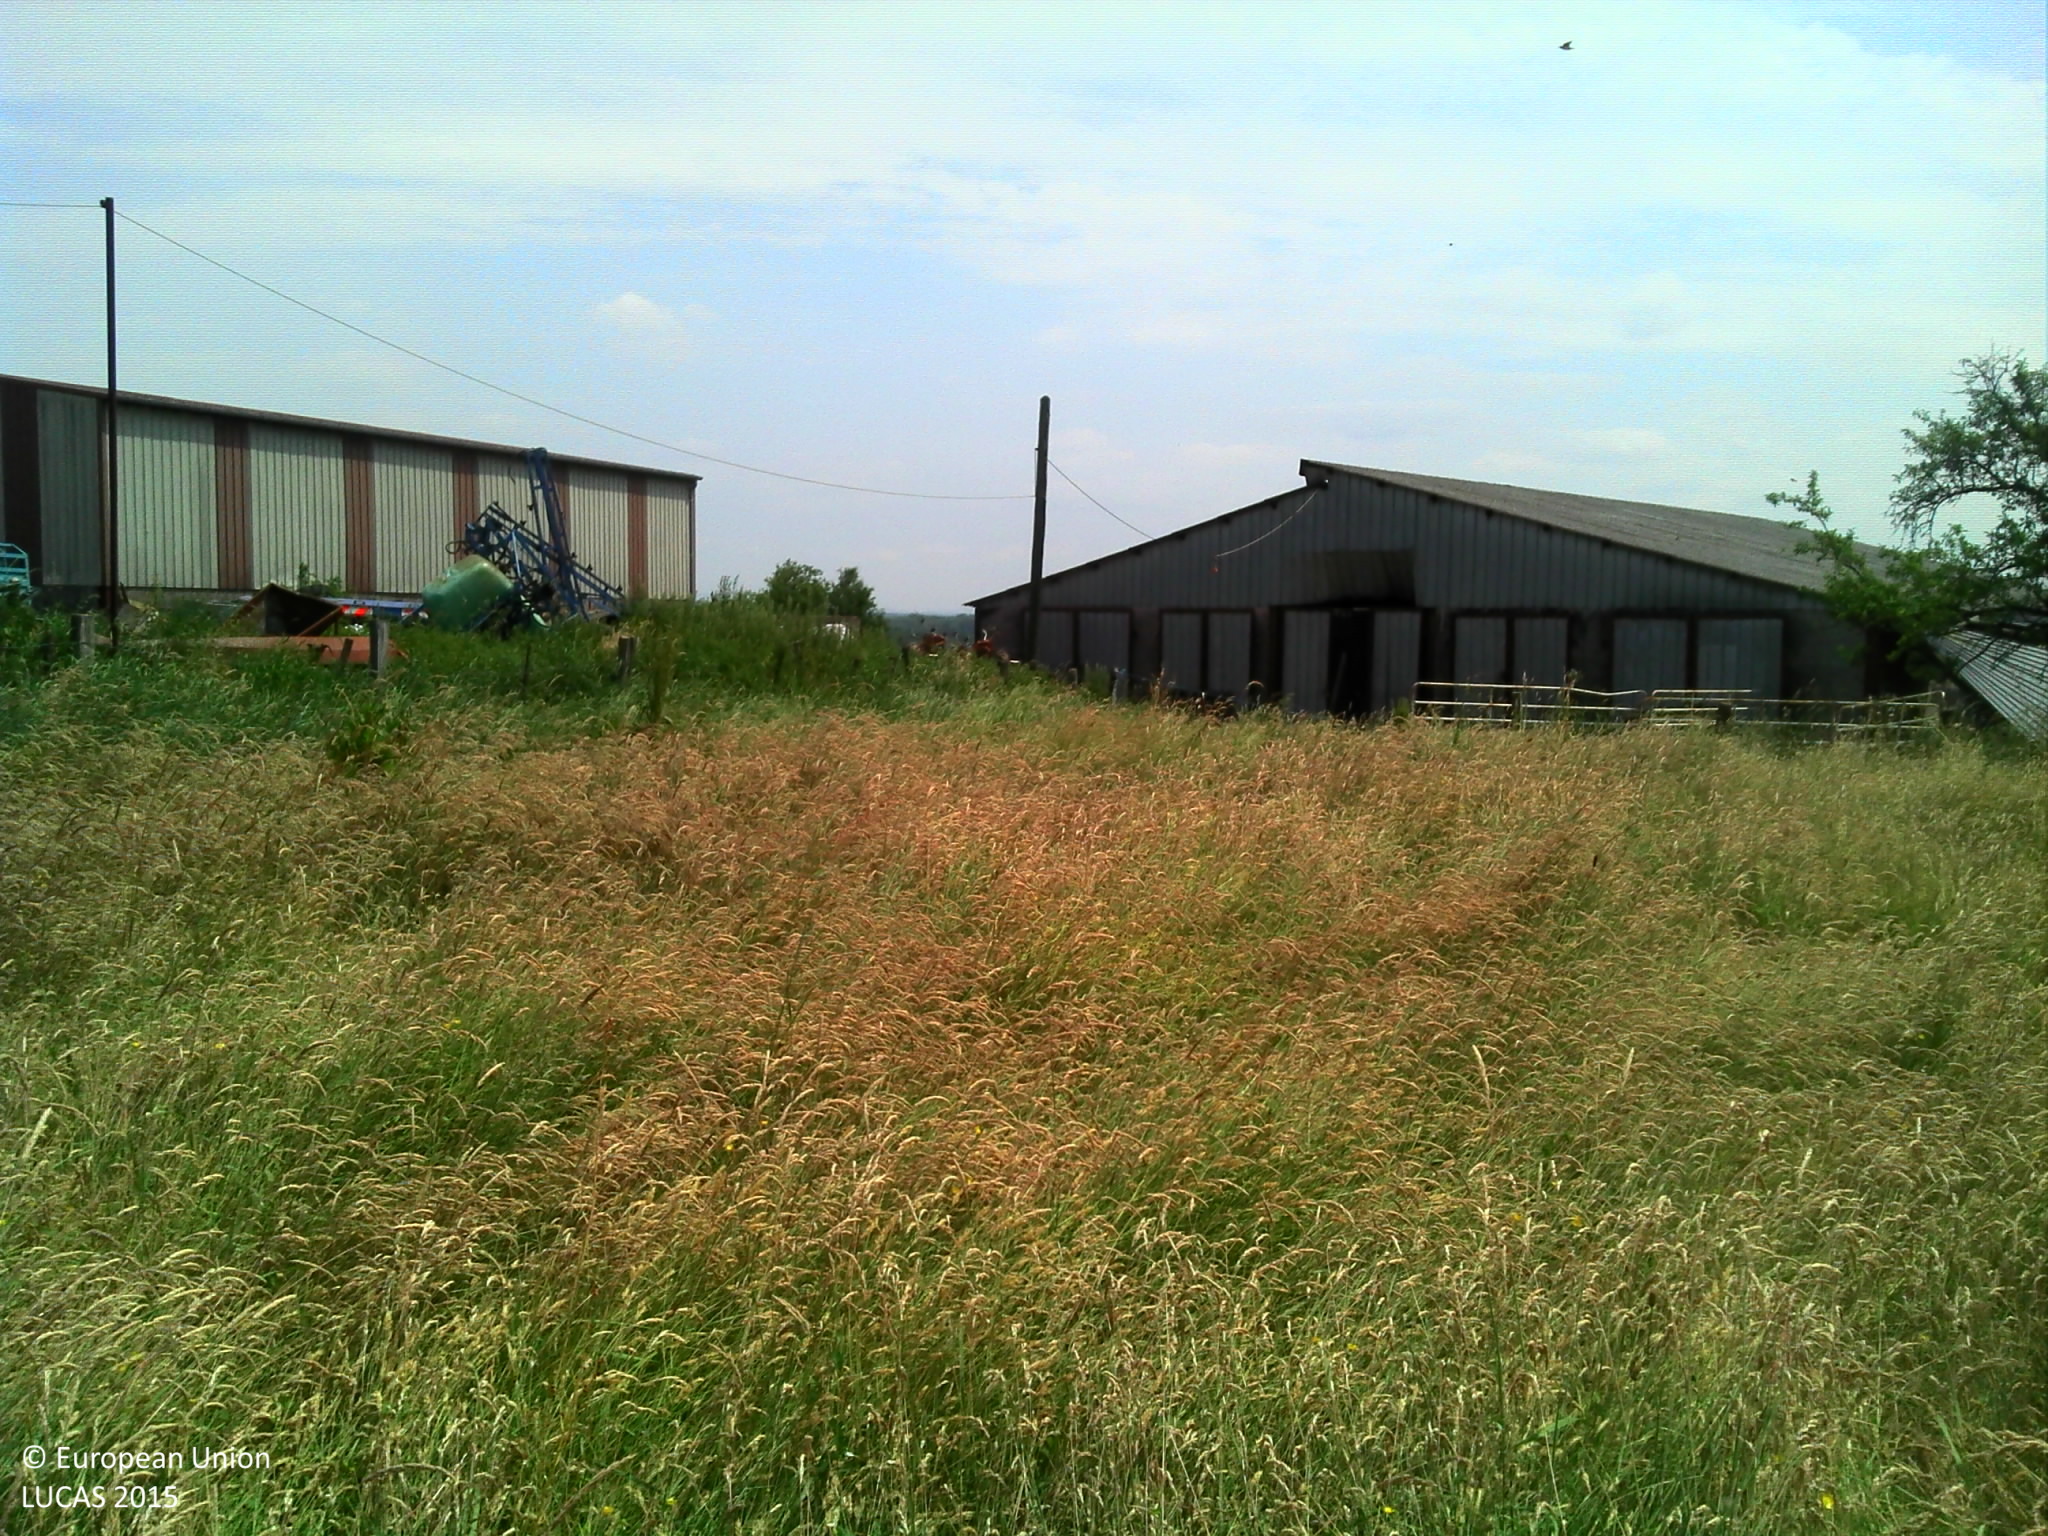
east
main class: Grassland
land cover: Grassland without tree/shrub cover
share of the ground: > 75 %
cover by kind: herbaceous plants 100 %
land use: Agriculture (excluding fallow land and kitchen gardens)
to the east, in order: Grassland without tree/shrub cover; Artificial constructions in urban areas; Broadleaved woodland; Artificial constructions in urban areas; Shrubland without tree cover; Grassland without tree/shrub cover; Fences; Other fruit trees and berries; Fences; Grassland without tree/shrub cover; Fences; Grassland without tree/shrub cover
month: June
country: FR
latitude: 47.8525
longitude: 6.2188
